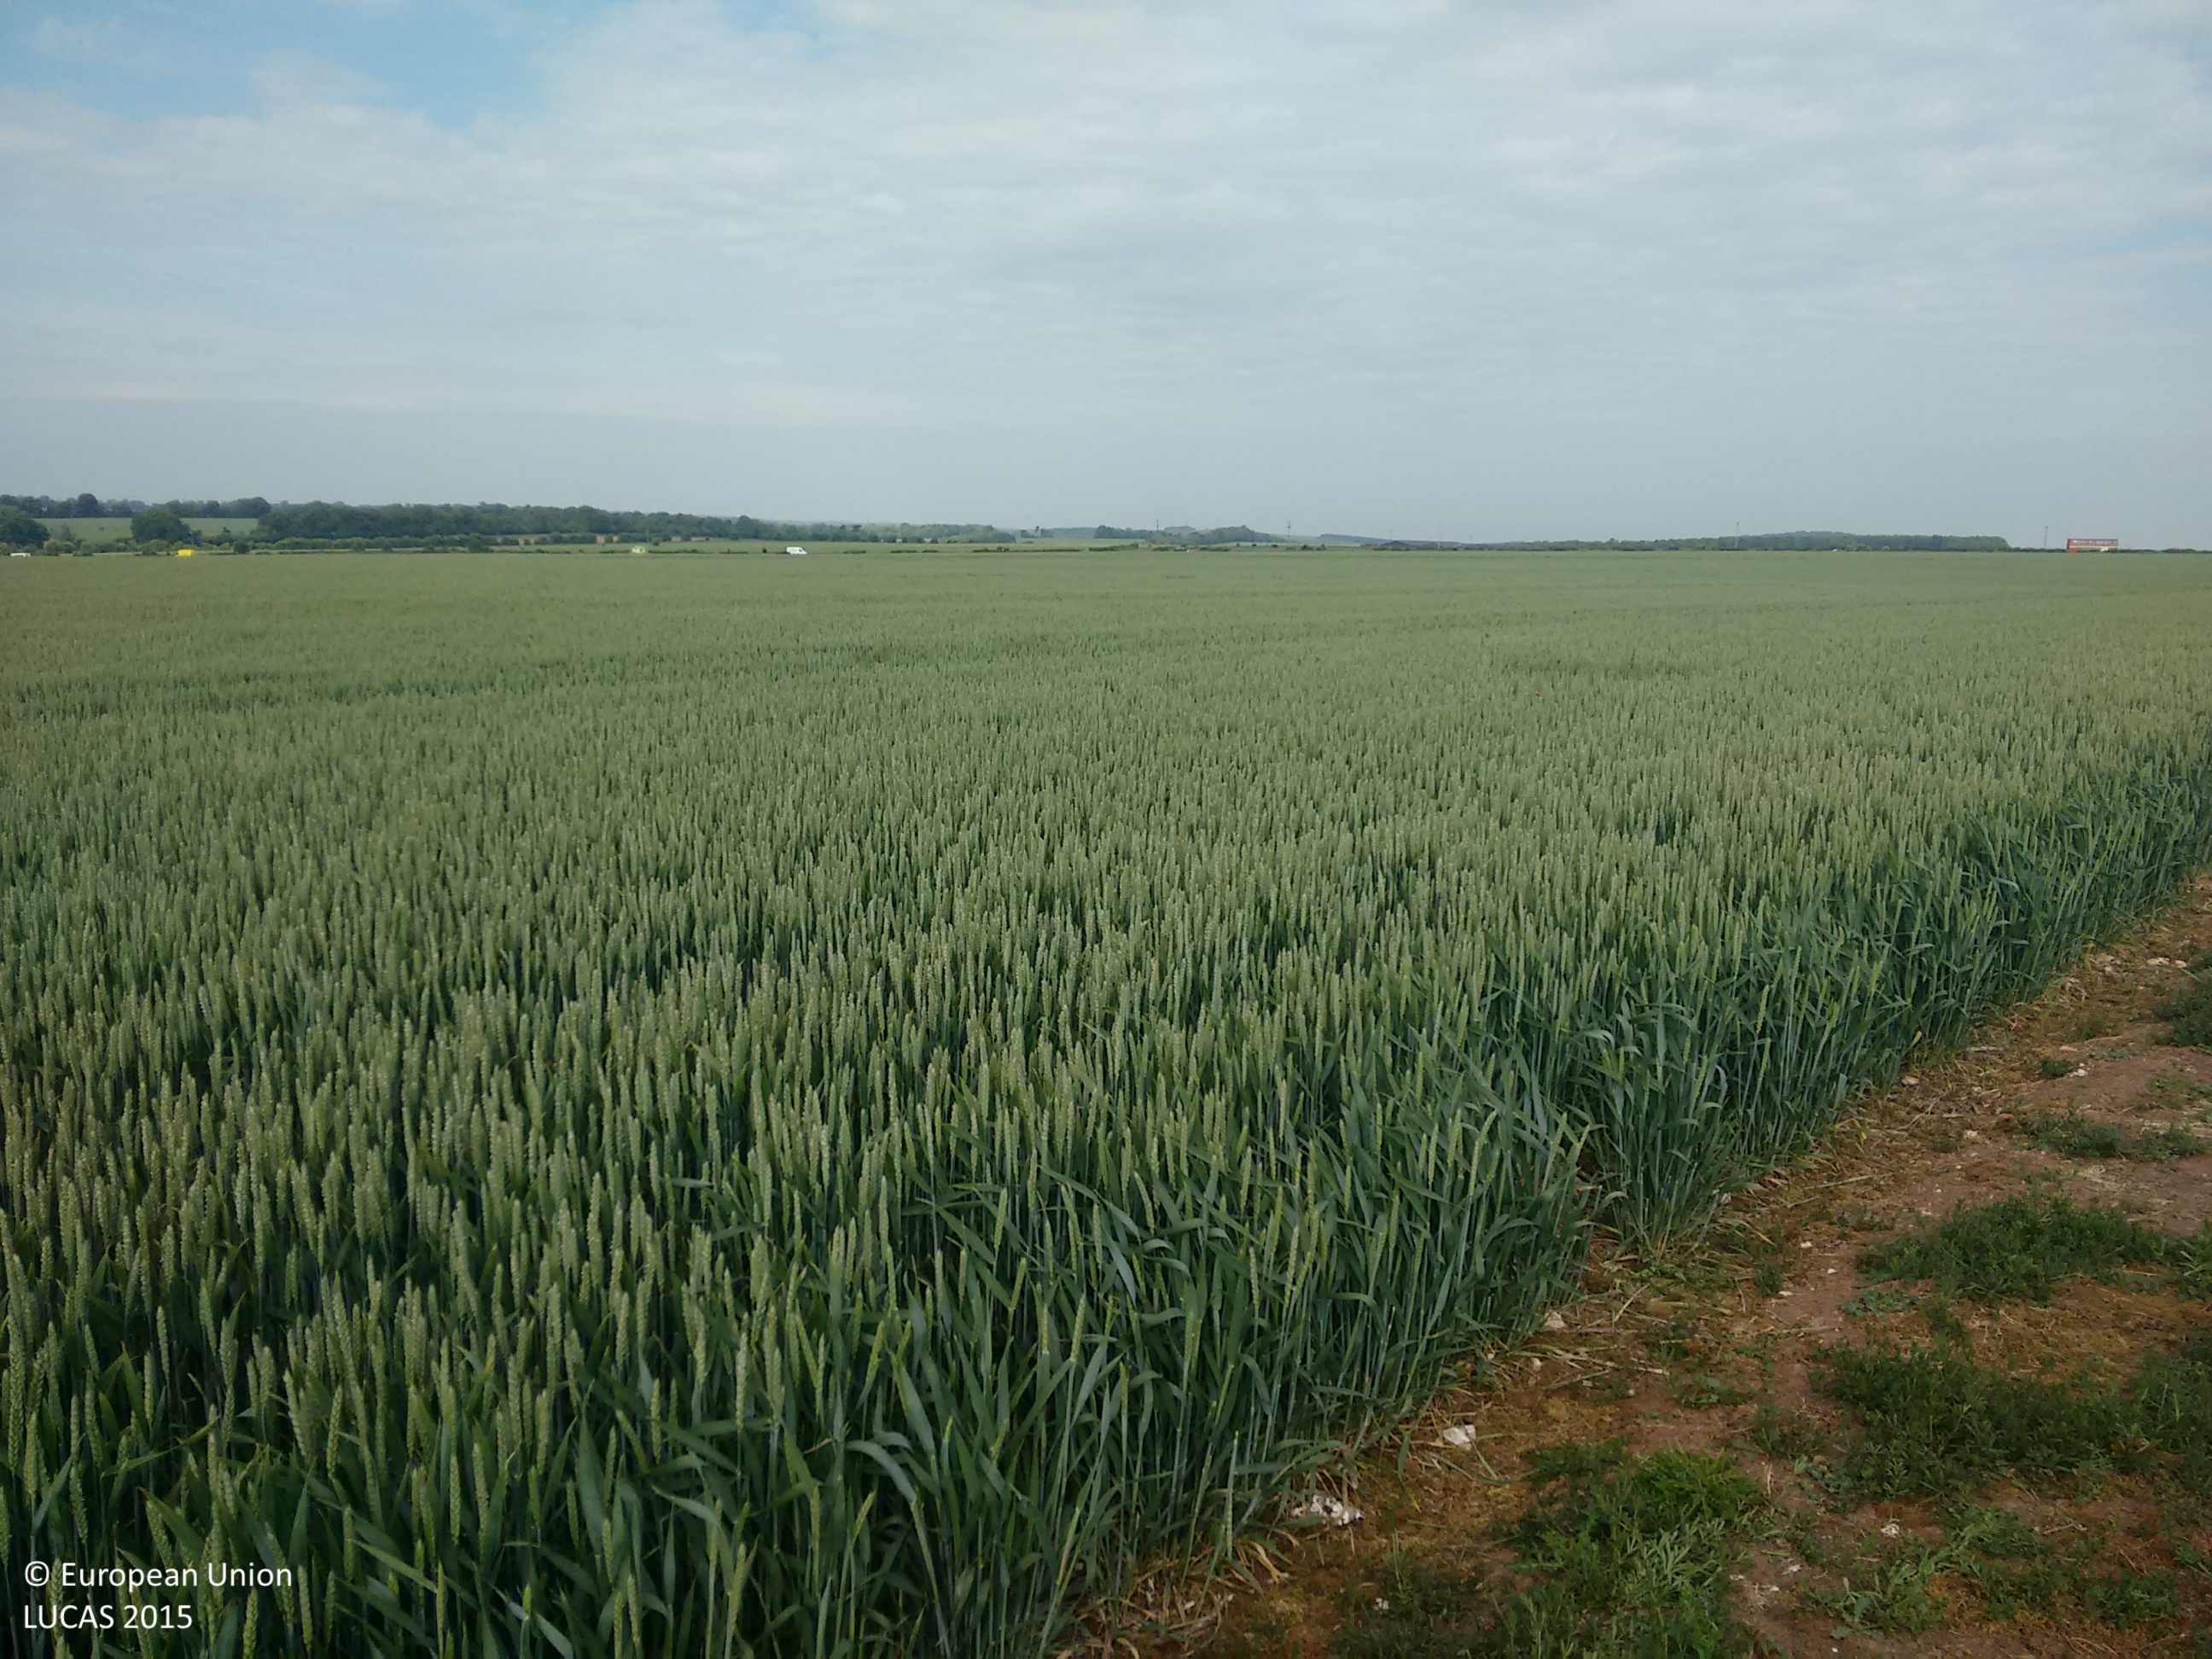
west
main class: Cropland
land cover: Barley
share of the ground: > 75 %
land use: Agriculture (excluding fallow land and kitchen gardens)
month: June
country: GB
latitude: 51.1157
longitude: -1.7834
